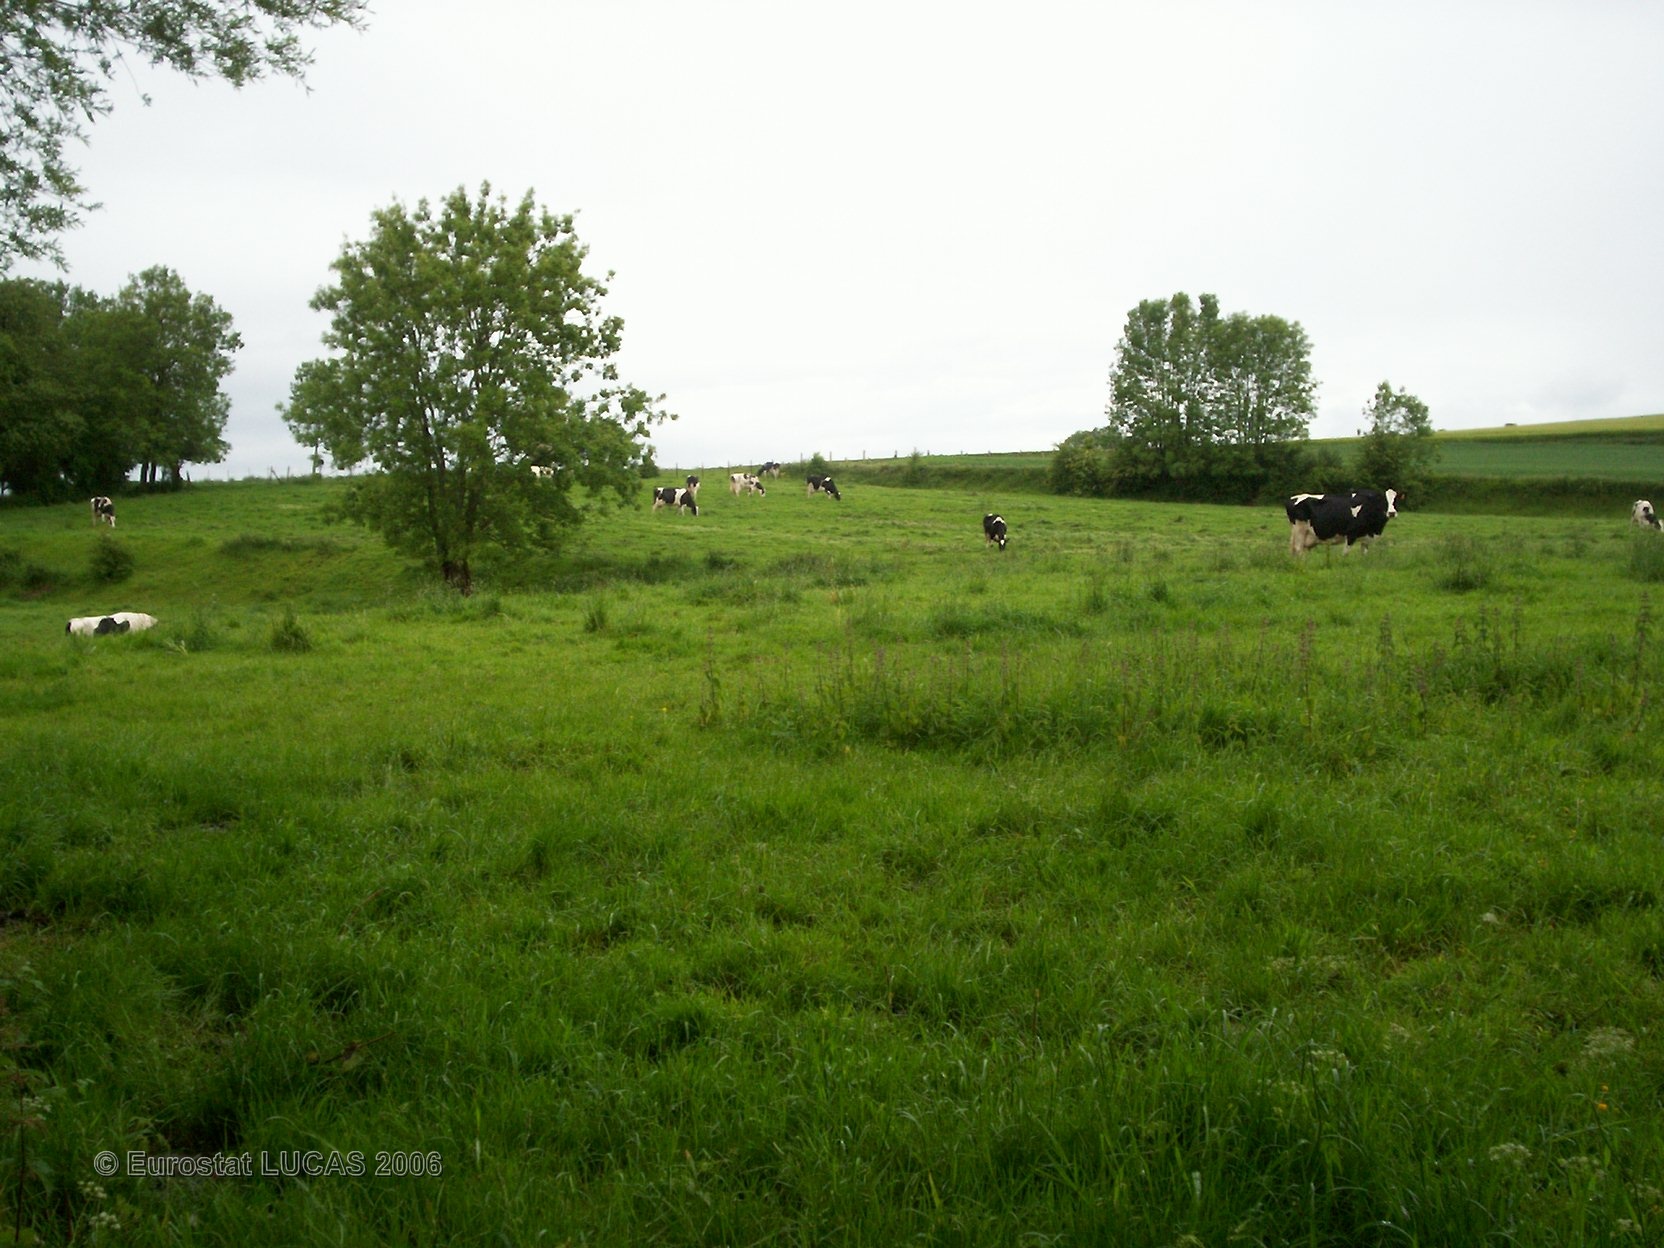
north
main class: Grassland
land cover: Grassland with sparse tree/shrub cover
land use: Agriculture (excluding fallow land and kitchen gardens)
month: May
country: FR
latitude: 50.4255
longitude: 2.5130
